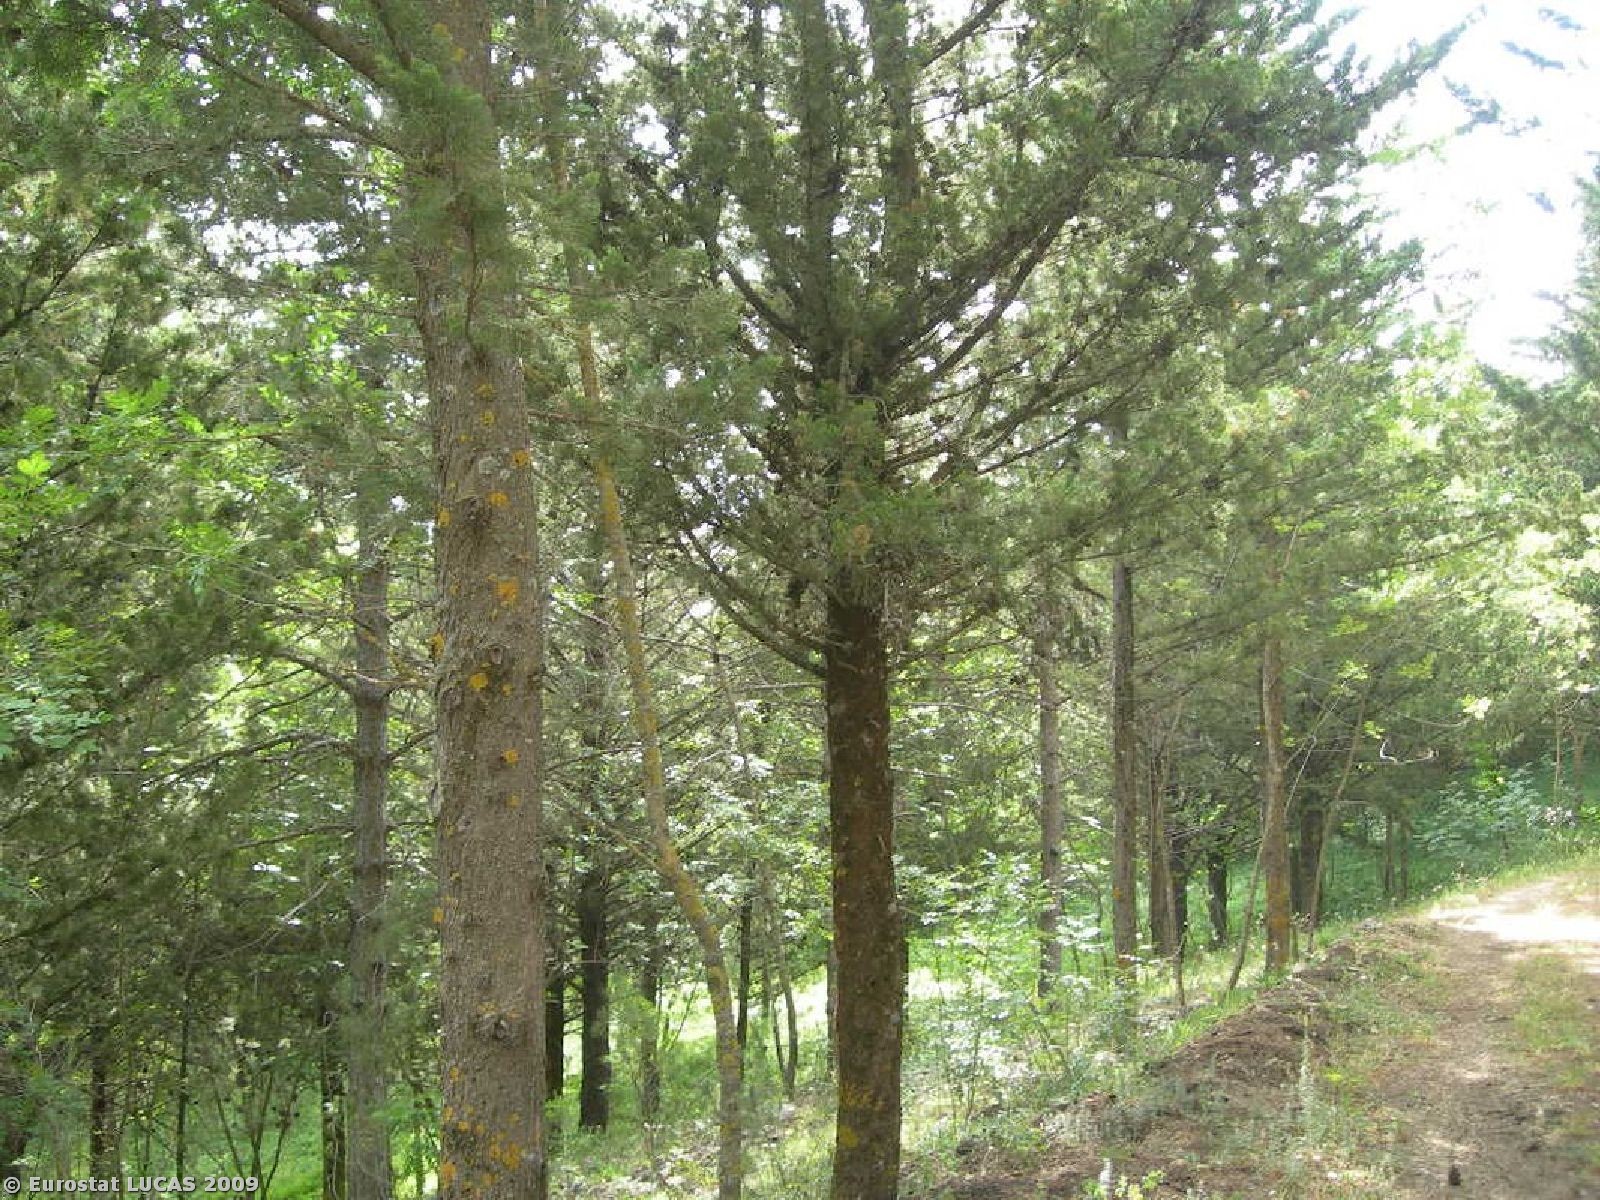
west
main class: Woodland
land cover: Mixed woodland
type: thermophilous deciduous forest
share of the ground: > 75 %
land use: Nature reserves
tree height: > 5 m
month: June
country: IT
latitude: 37.8057
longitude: 14.0712
